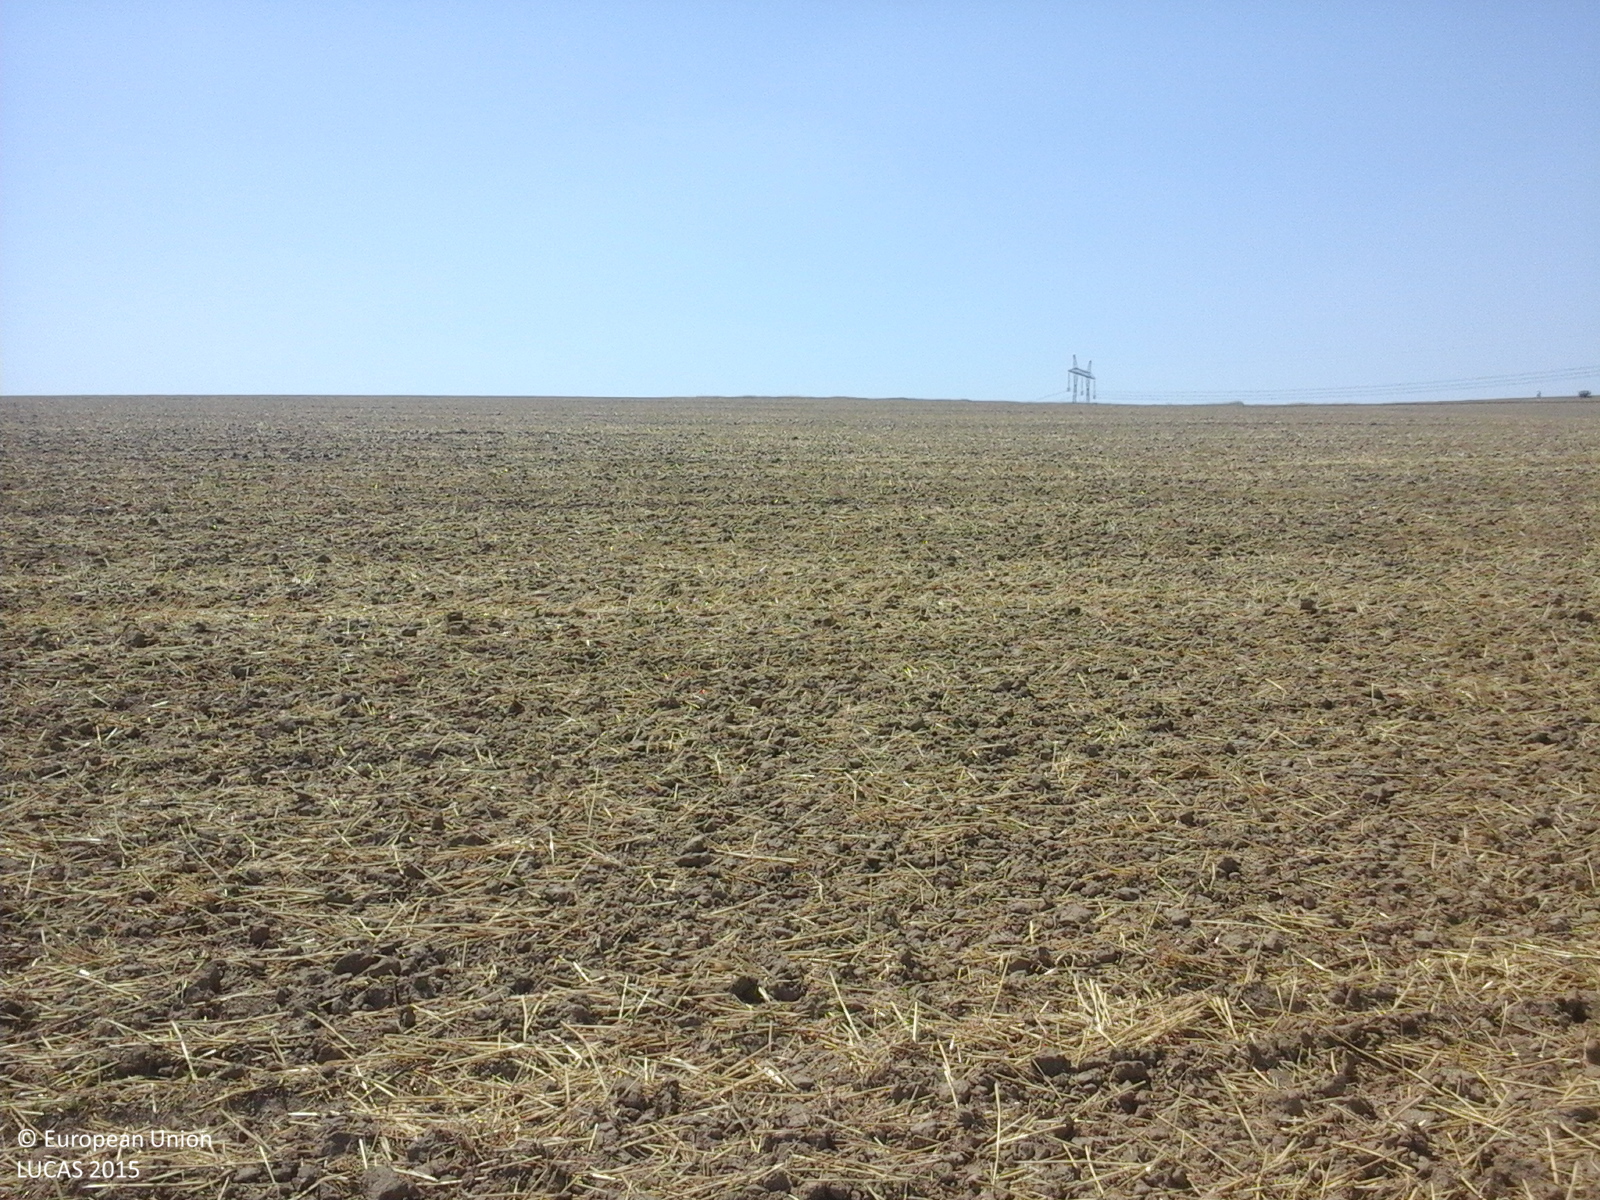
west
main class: Cropland
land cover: Common wheat
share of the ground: 10 - 25 %
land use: Agriculture (excluding fallow land and kitchen gardens)
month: August
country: RO
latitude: 44.5331
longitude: 28.1974
